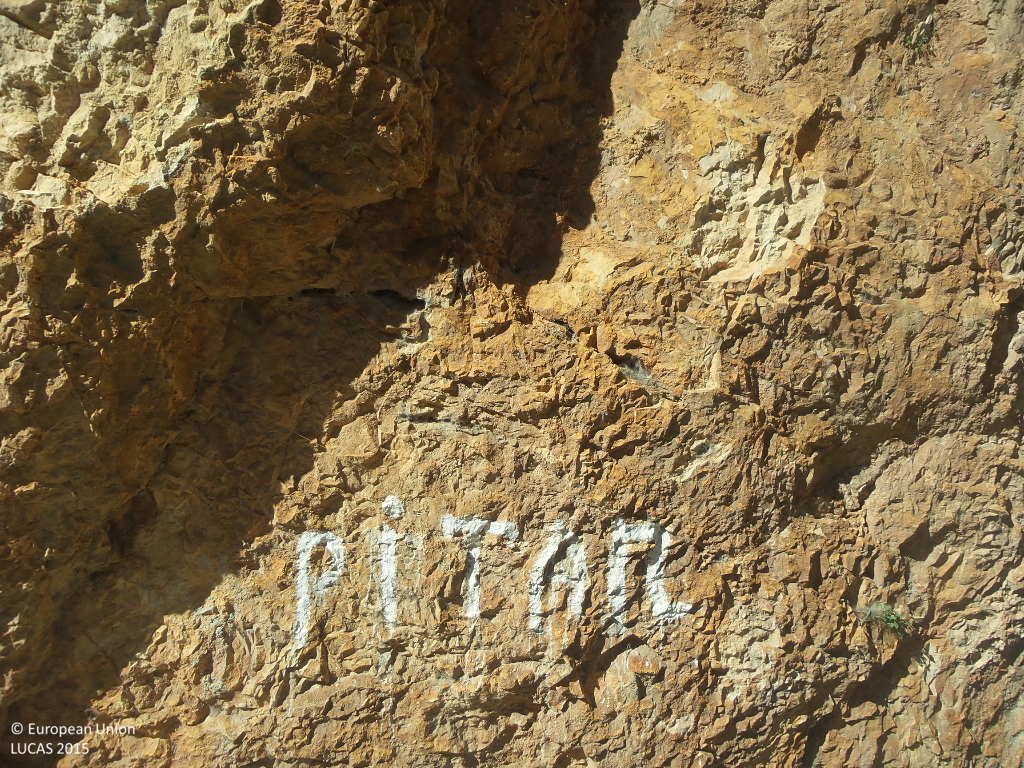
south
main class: Shrubland
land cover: Shrubland without tree cover
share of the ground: 10 - 25 %
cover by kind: unconsolidated bare surface 60 %, shrubs 20 %, herbaceous plants 20 %
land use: Semi-natural and natural areas not in use
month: July
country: ES
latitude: 41.1851
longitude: -1.8881
